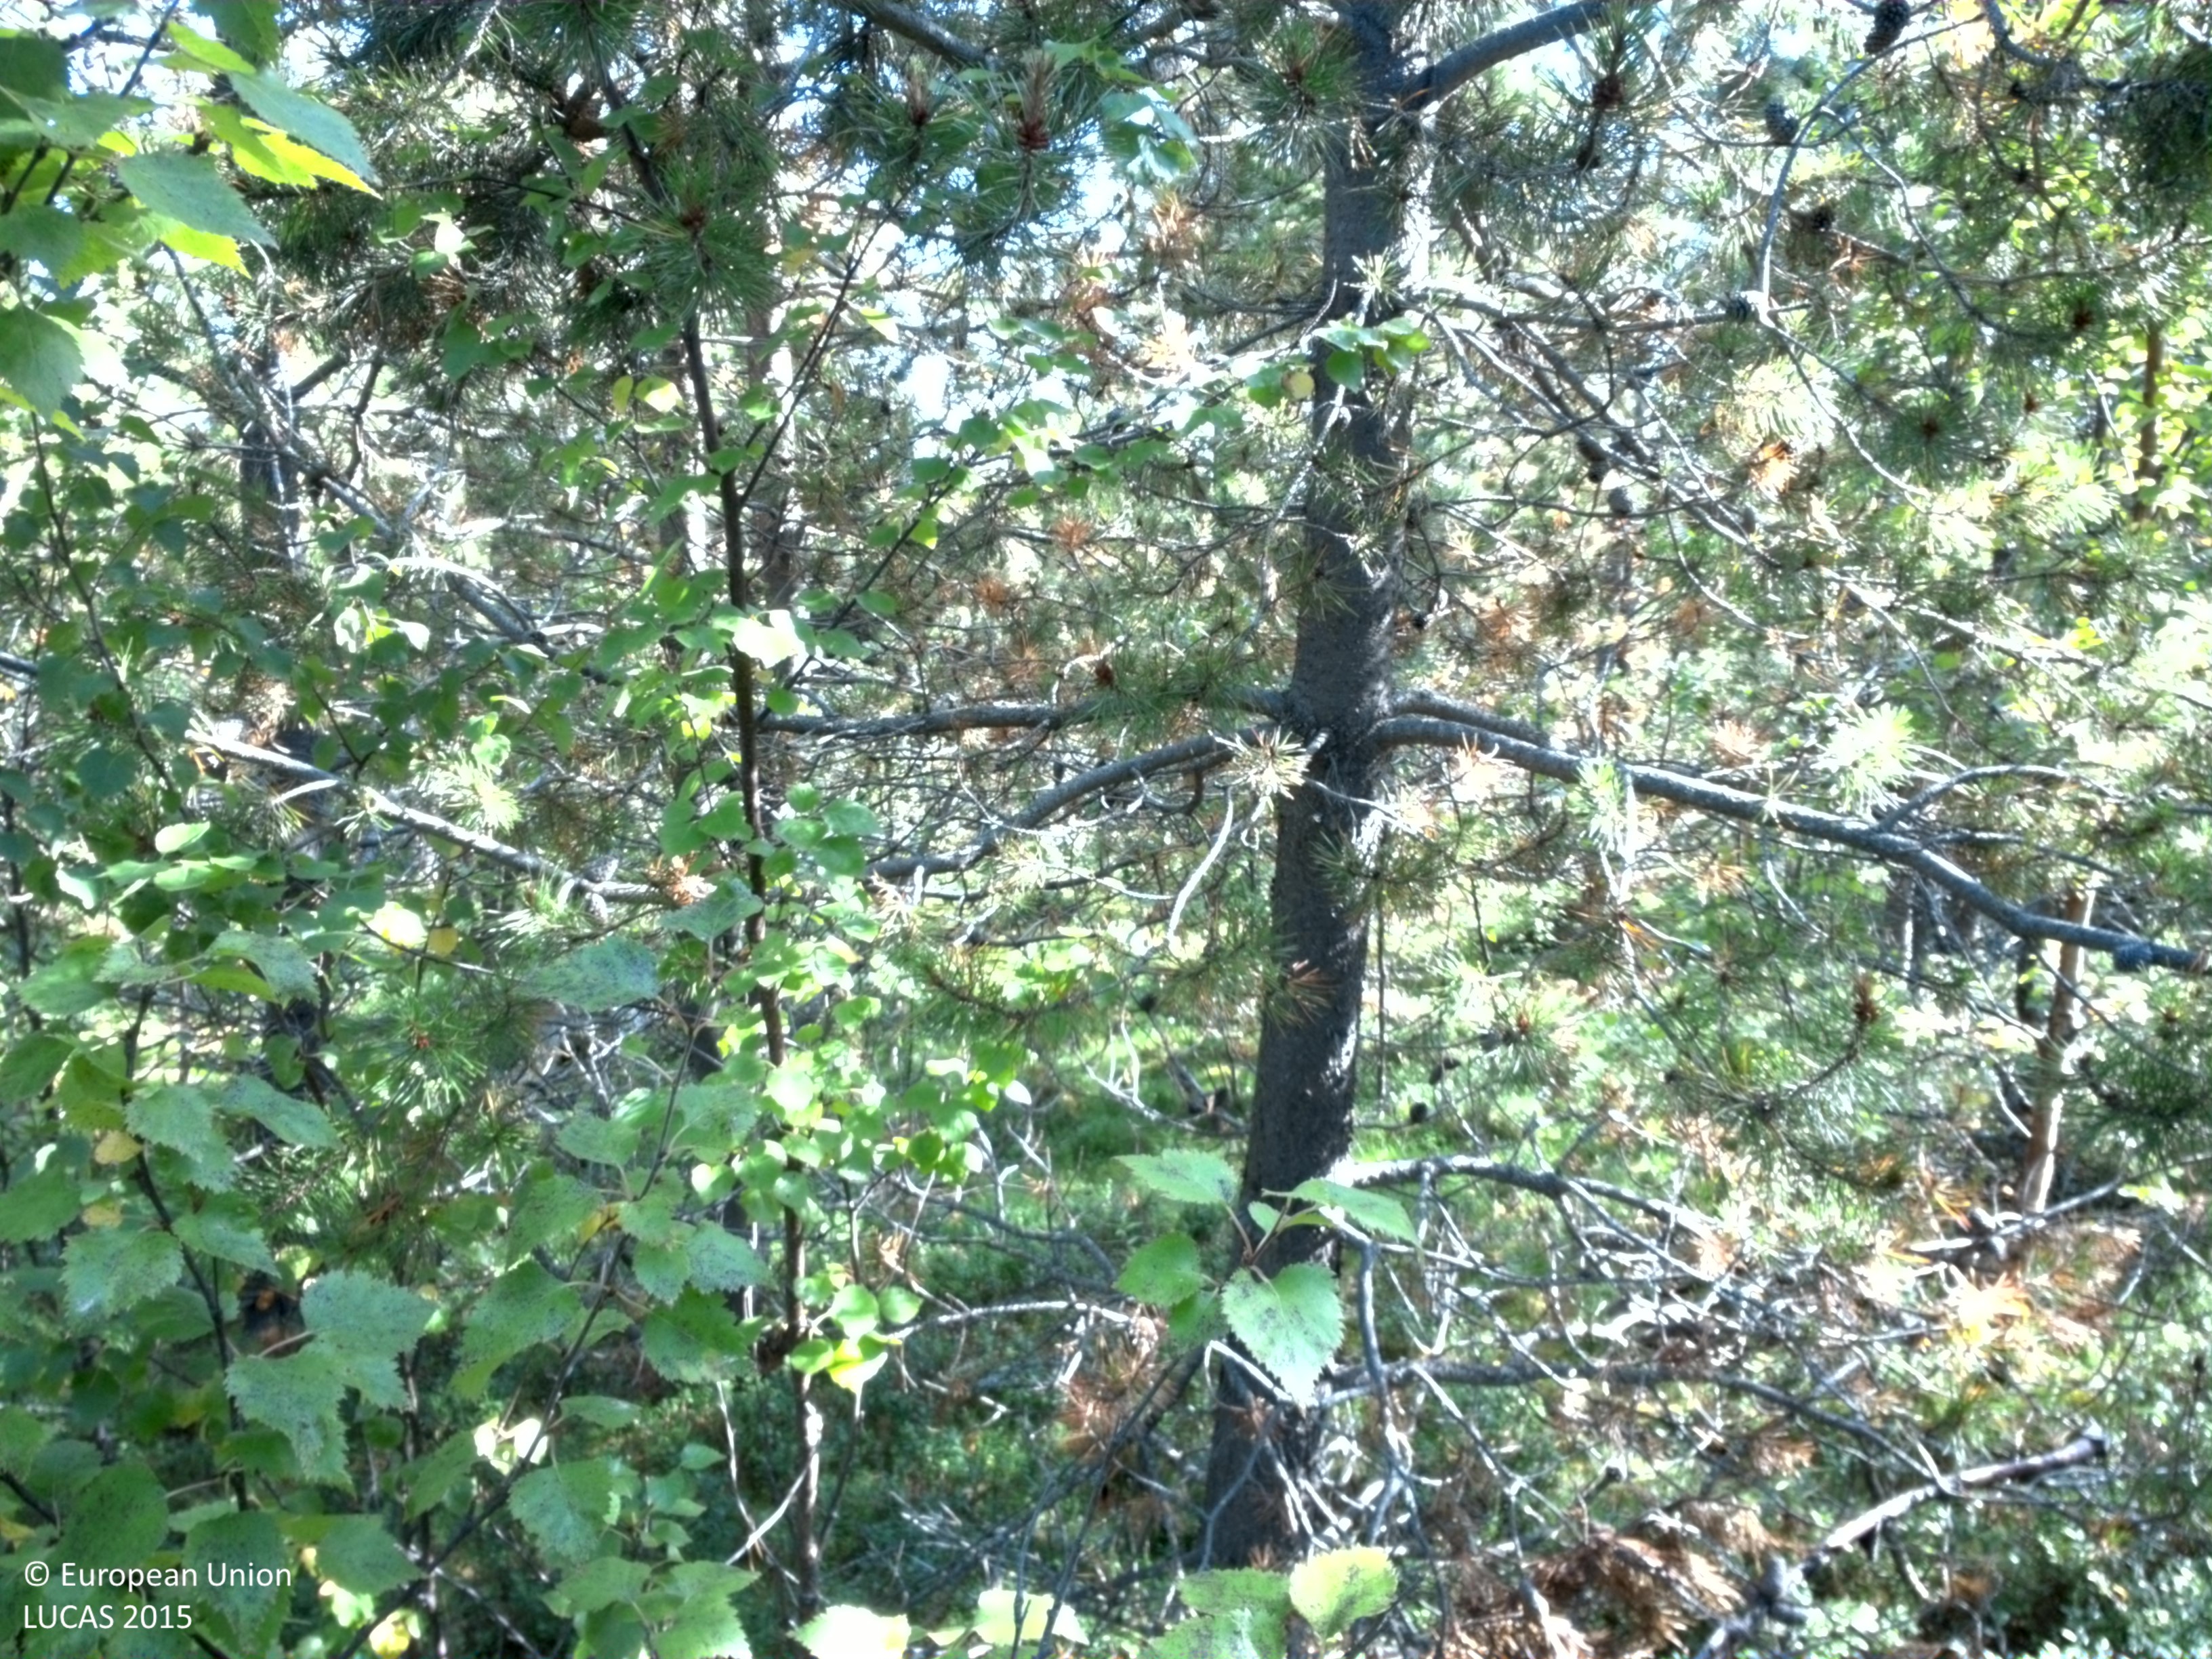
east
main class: Woodland
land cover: Pine dominated mixed woodland
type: exotic forest
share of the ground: 50 - 75 %
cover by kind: coniferous forest trees 35 %, shrubs 25 %, herbaceous plants 20 %, broadleaved forest trees 15 %, lichens and mosses 5 %
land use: Forestry
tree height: > 5 m
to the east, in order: Pine dominated mixed woodland; Spruce dominated mixed woodland; Shrubland with sparse tree cover; Shrubland without tree cover; Spruce dominated mixed woodland; Shrubland with sparse tree cover; Broadleaved woodland; Shrubland with sparse tree cover; Shrubland without tree cover
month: September
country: SE
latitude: 65.0614
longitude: 16.5322
